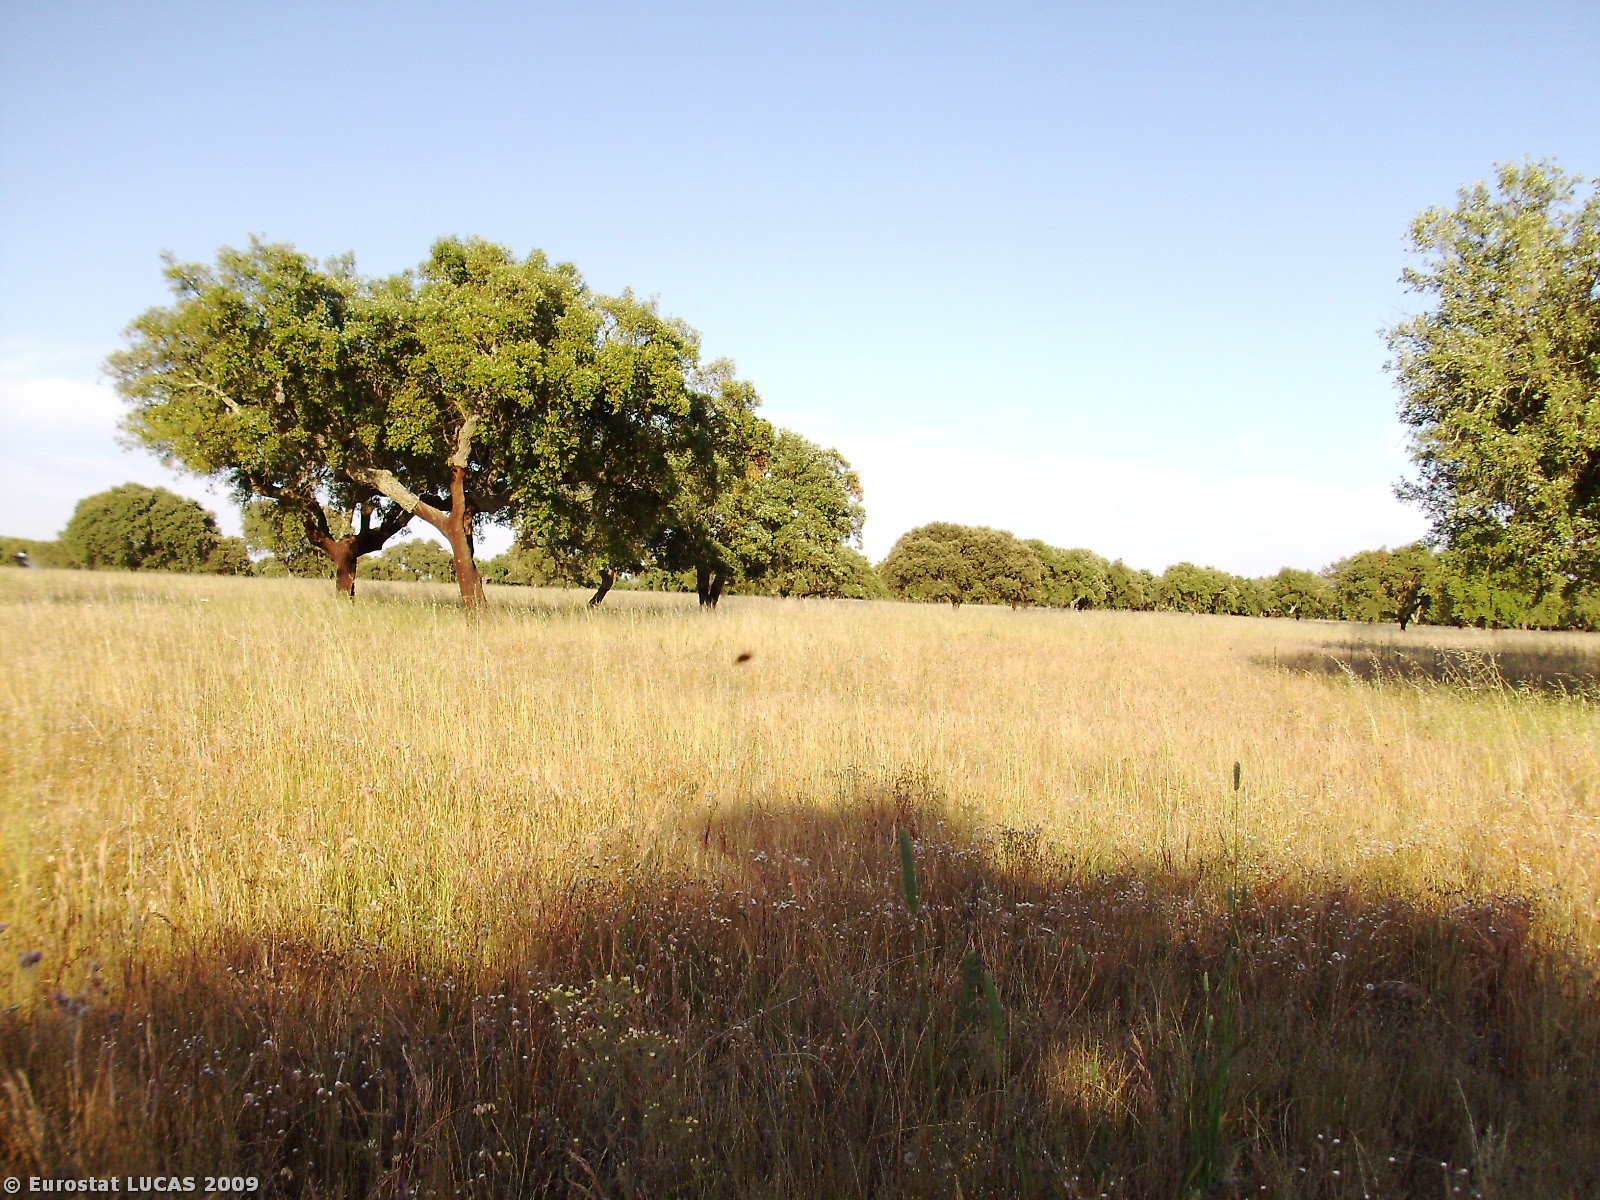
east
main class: Woodland
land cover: Broadleaved woodland
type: broadleaved evergreen forest
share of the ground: 10 - 25 %
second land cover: Grassland with sparse tree/shrub cover
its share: > 75 %
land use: Forestry
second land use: Agriculture (excluding fallow land and kitchen gardens)
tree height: > 5 m
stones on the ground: 25 - 50 %
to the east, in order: Broadleaved woodland; Grassland with sparse tree/shrub cover; Broadleaved woodland
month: May
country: PT
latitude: 38.9123
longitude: -7.7443
